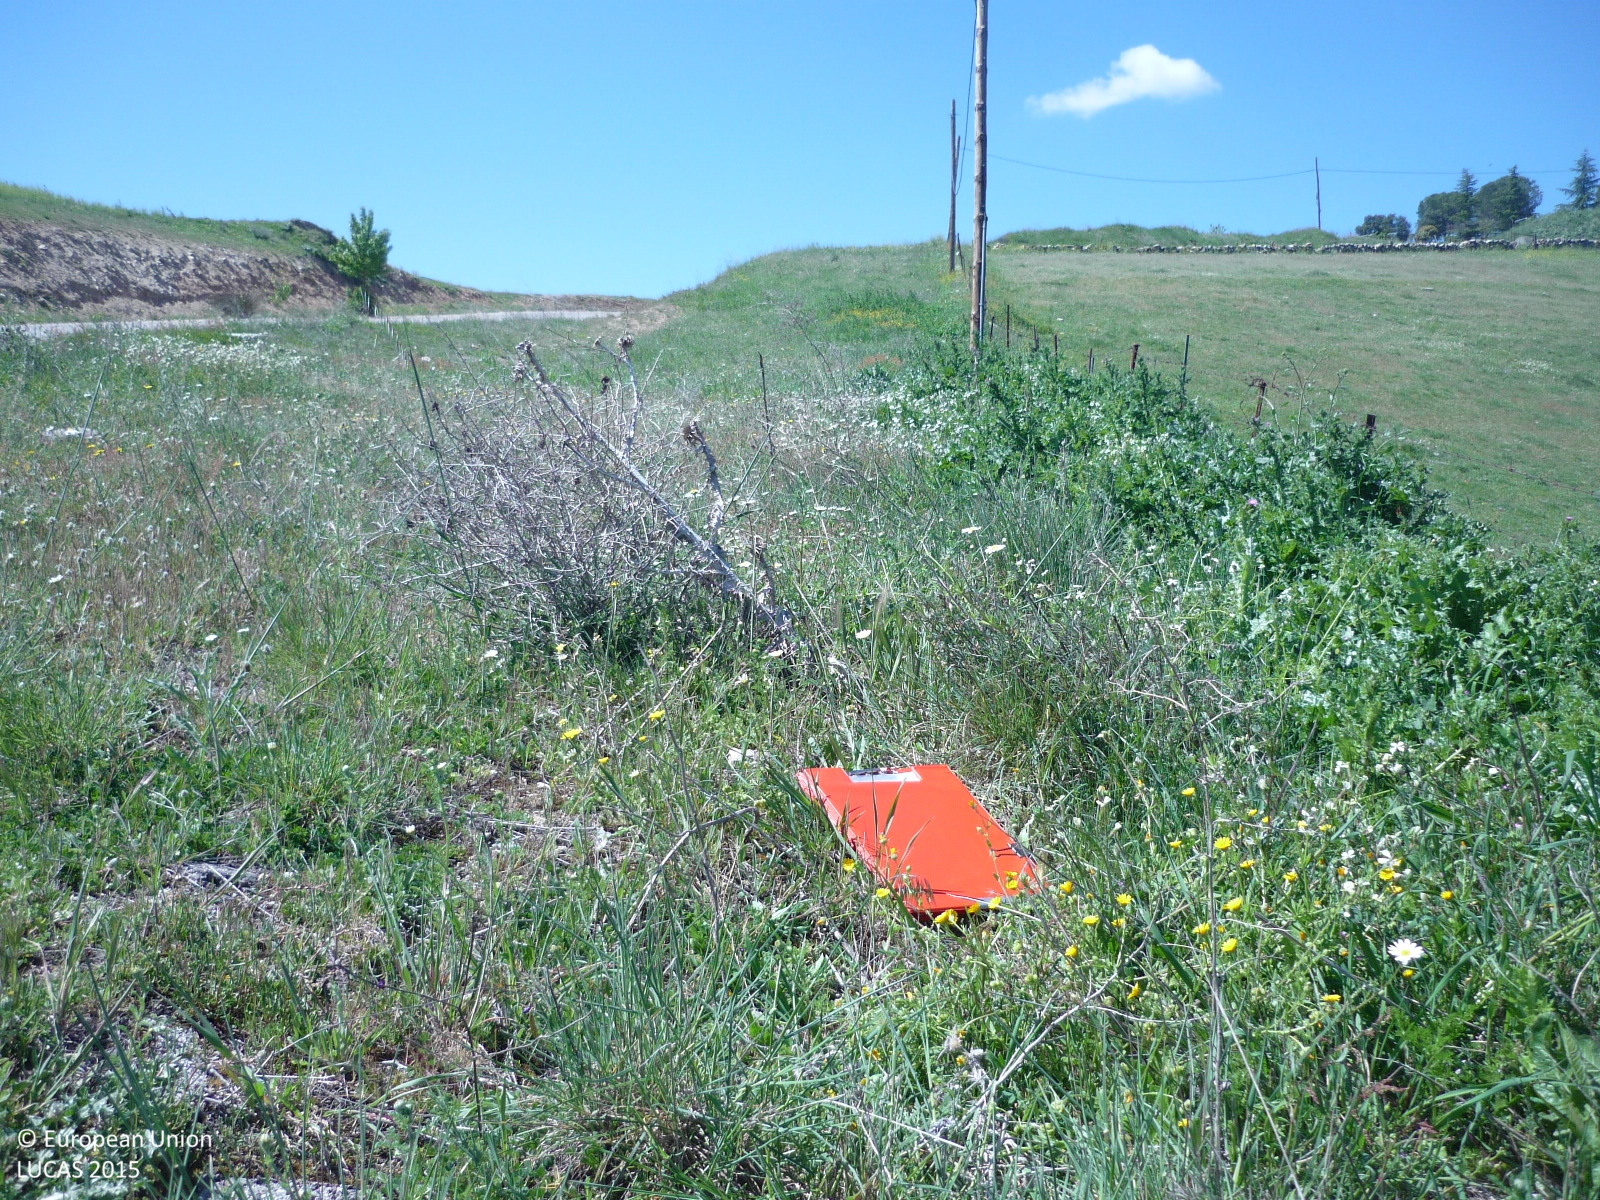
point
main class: Grassland
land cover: Grassland without tree/shrub cover
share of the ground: > 75 %
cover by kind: herbaceous plants 75 %, consolidated bare surface 25 %
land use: Semi-natural and natural areas not in use
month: April
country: ES
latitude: 40.7293
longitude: -3.5731
